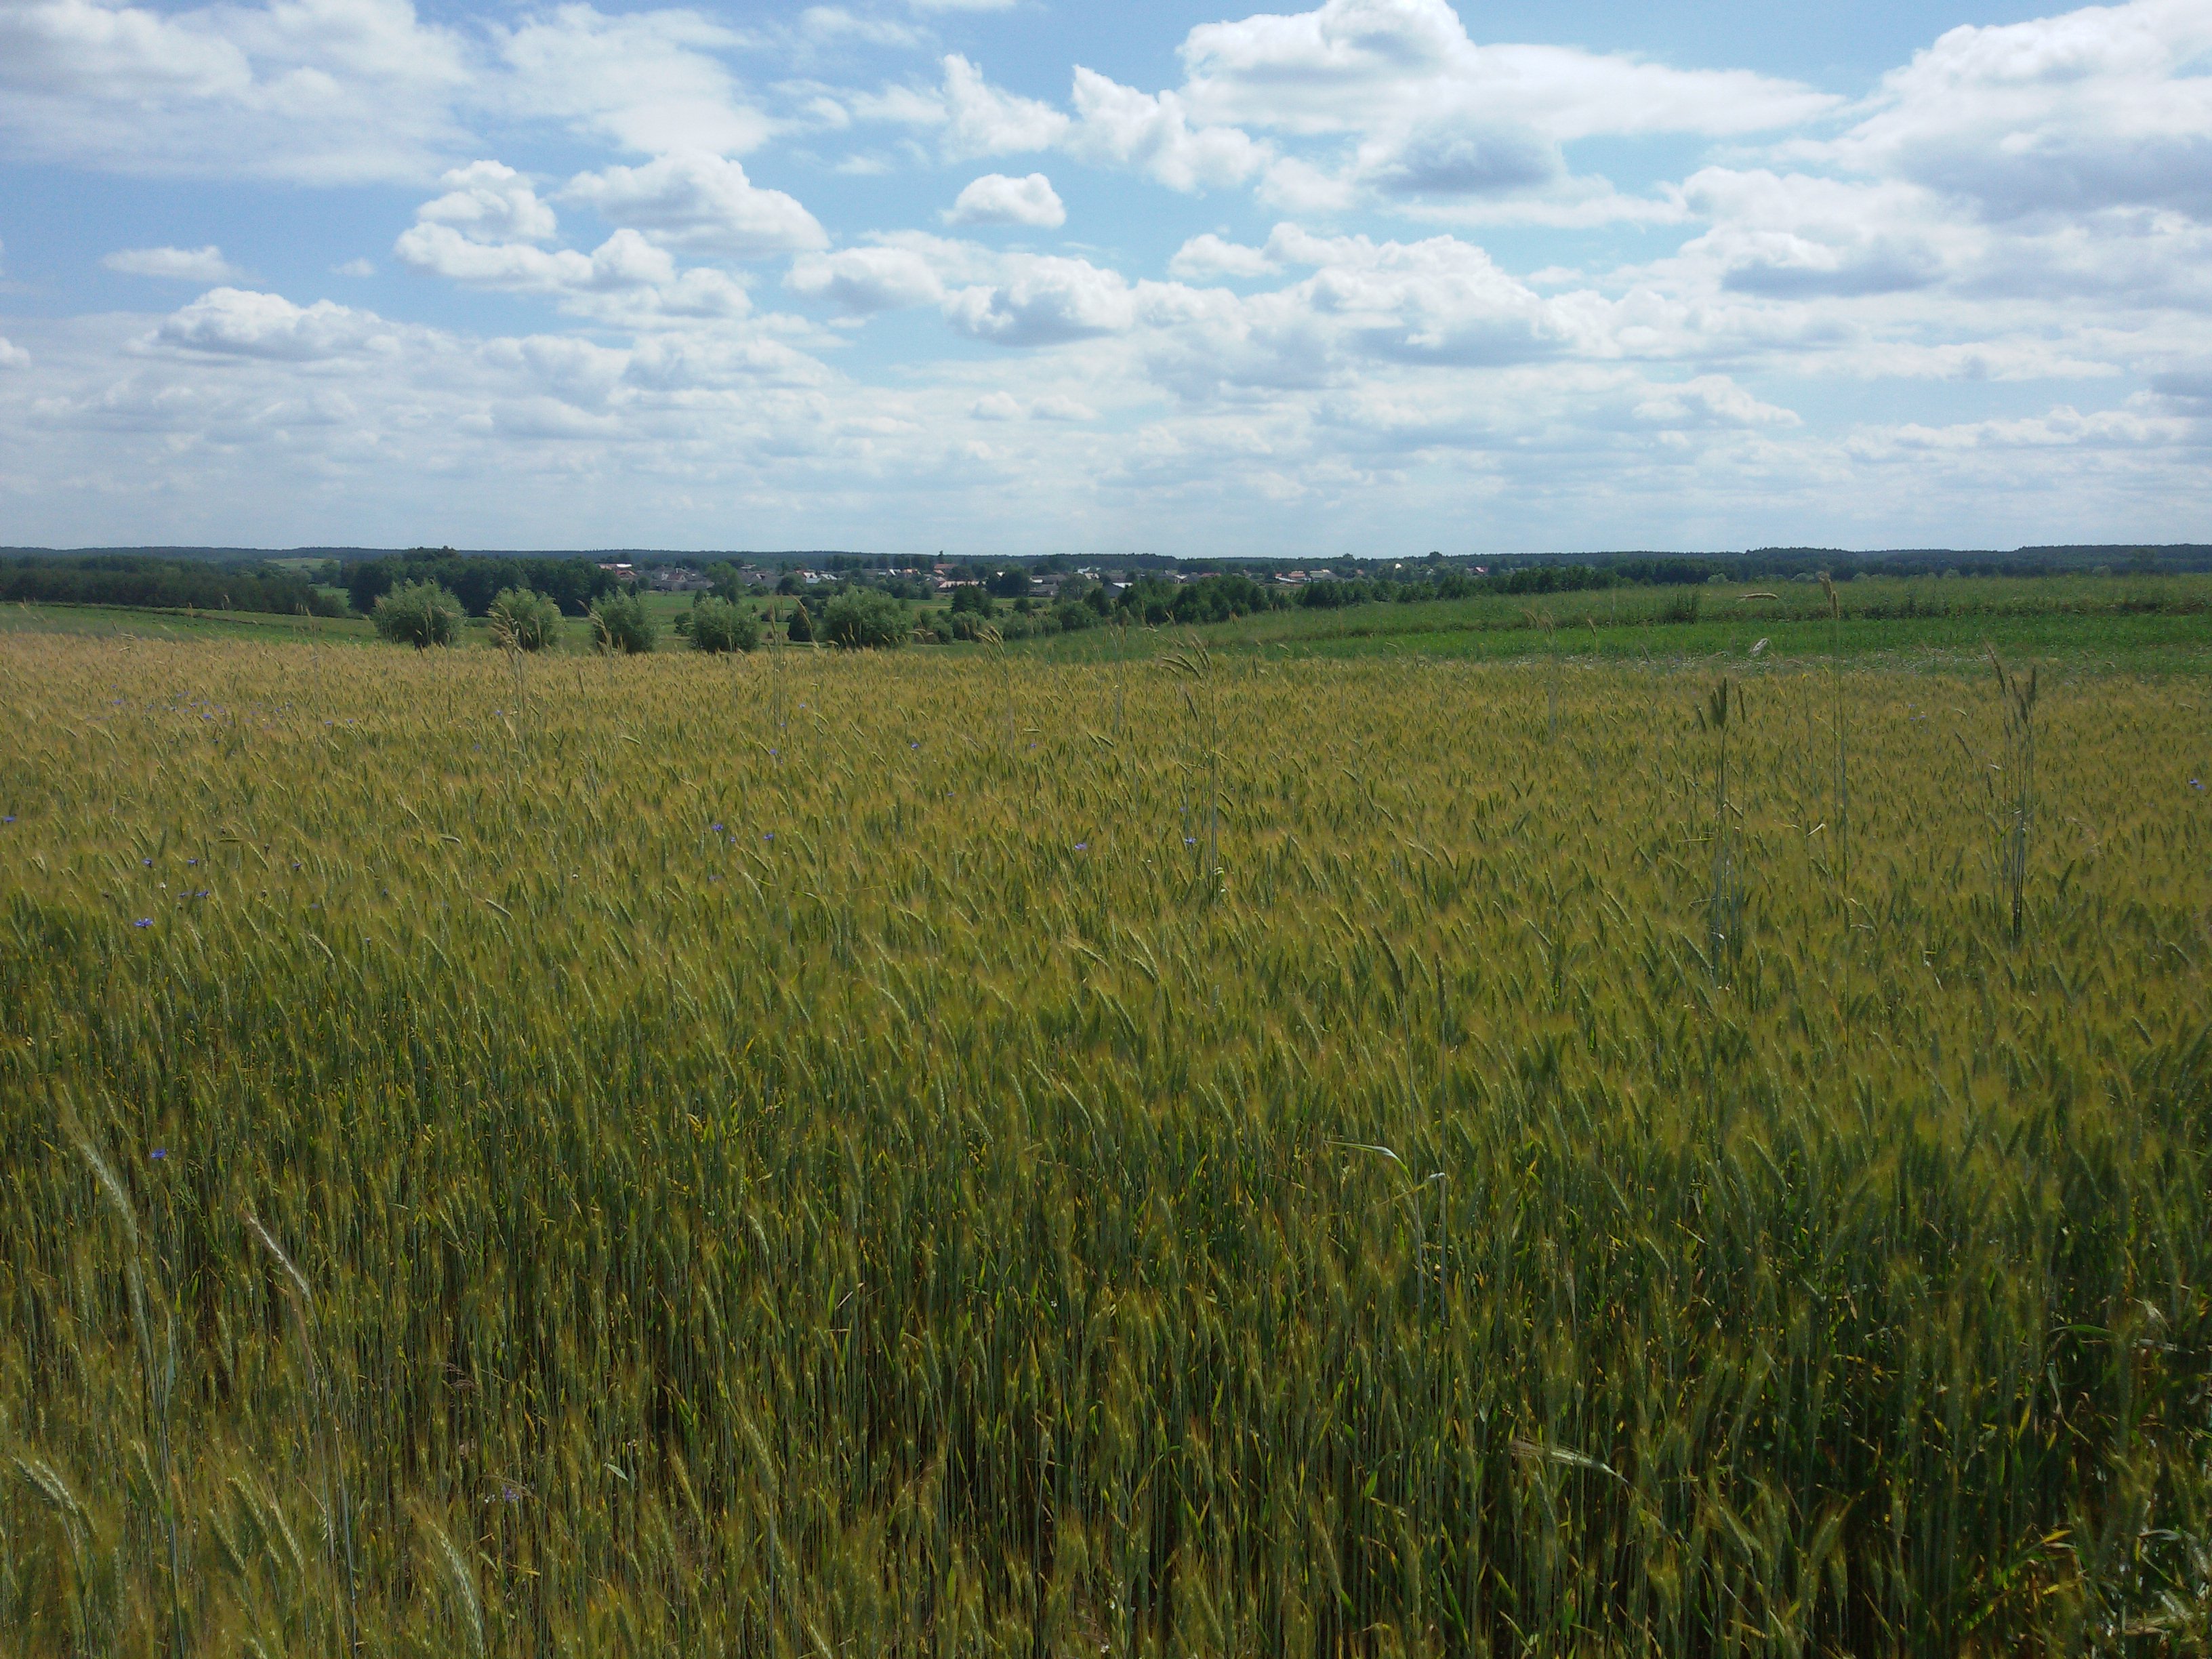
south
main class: Cropland
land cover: Common wheat
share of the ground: > 75 %
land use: Agriculture (excluding fallow land and kitchen gardens)
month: June
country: PL
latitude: 53.3776
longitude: 22.0694
